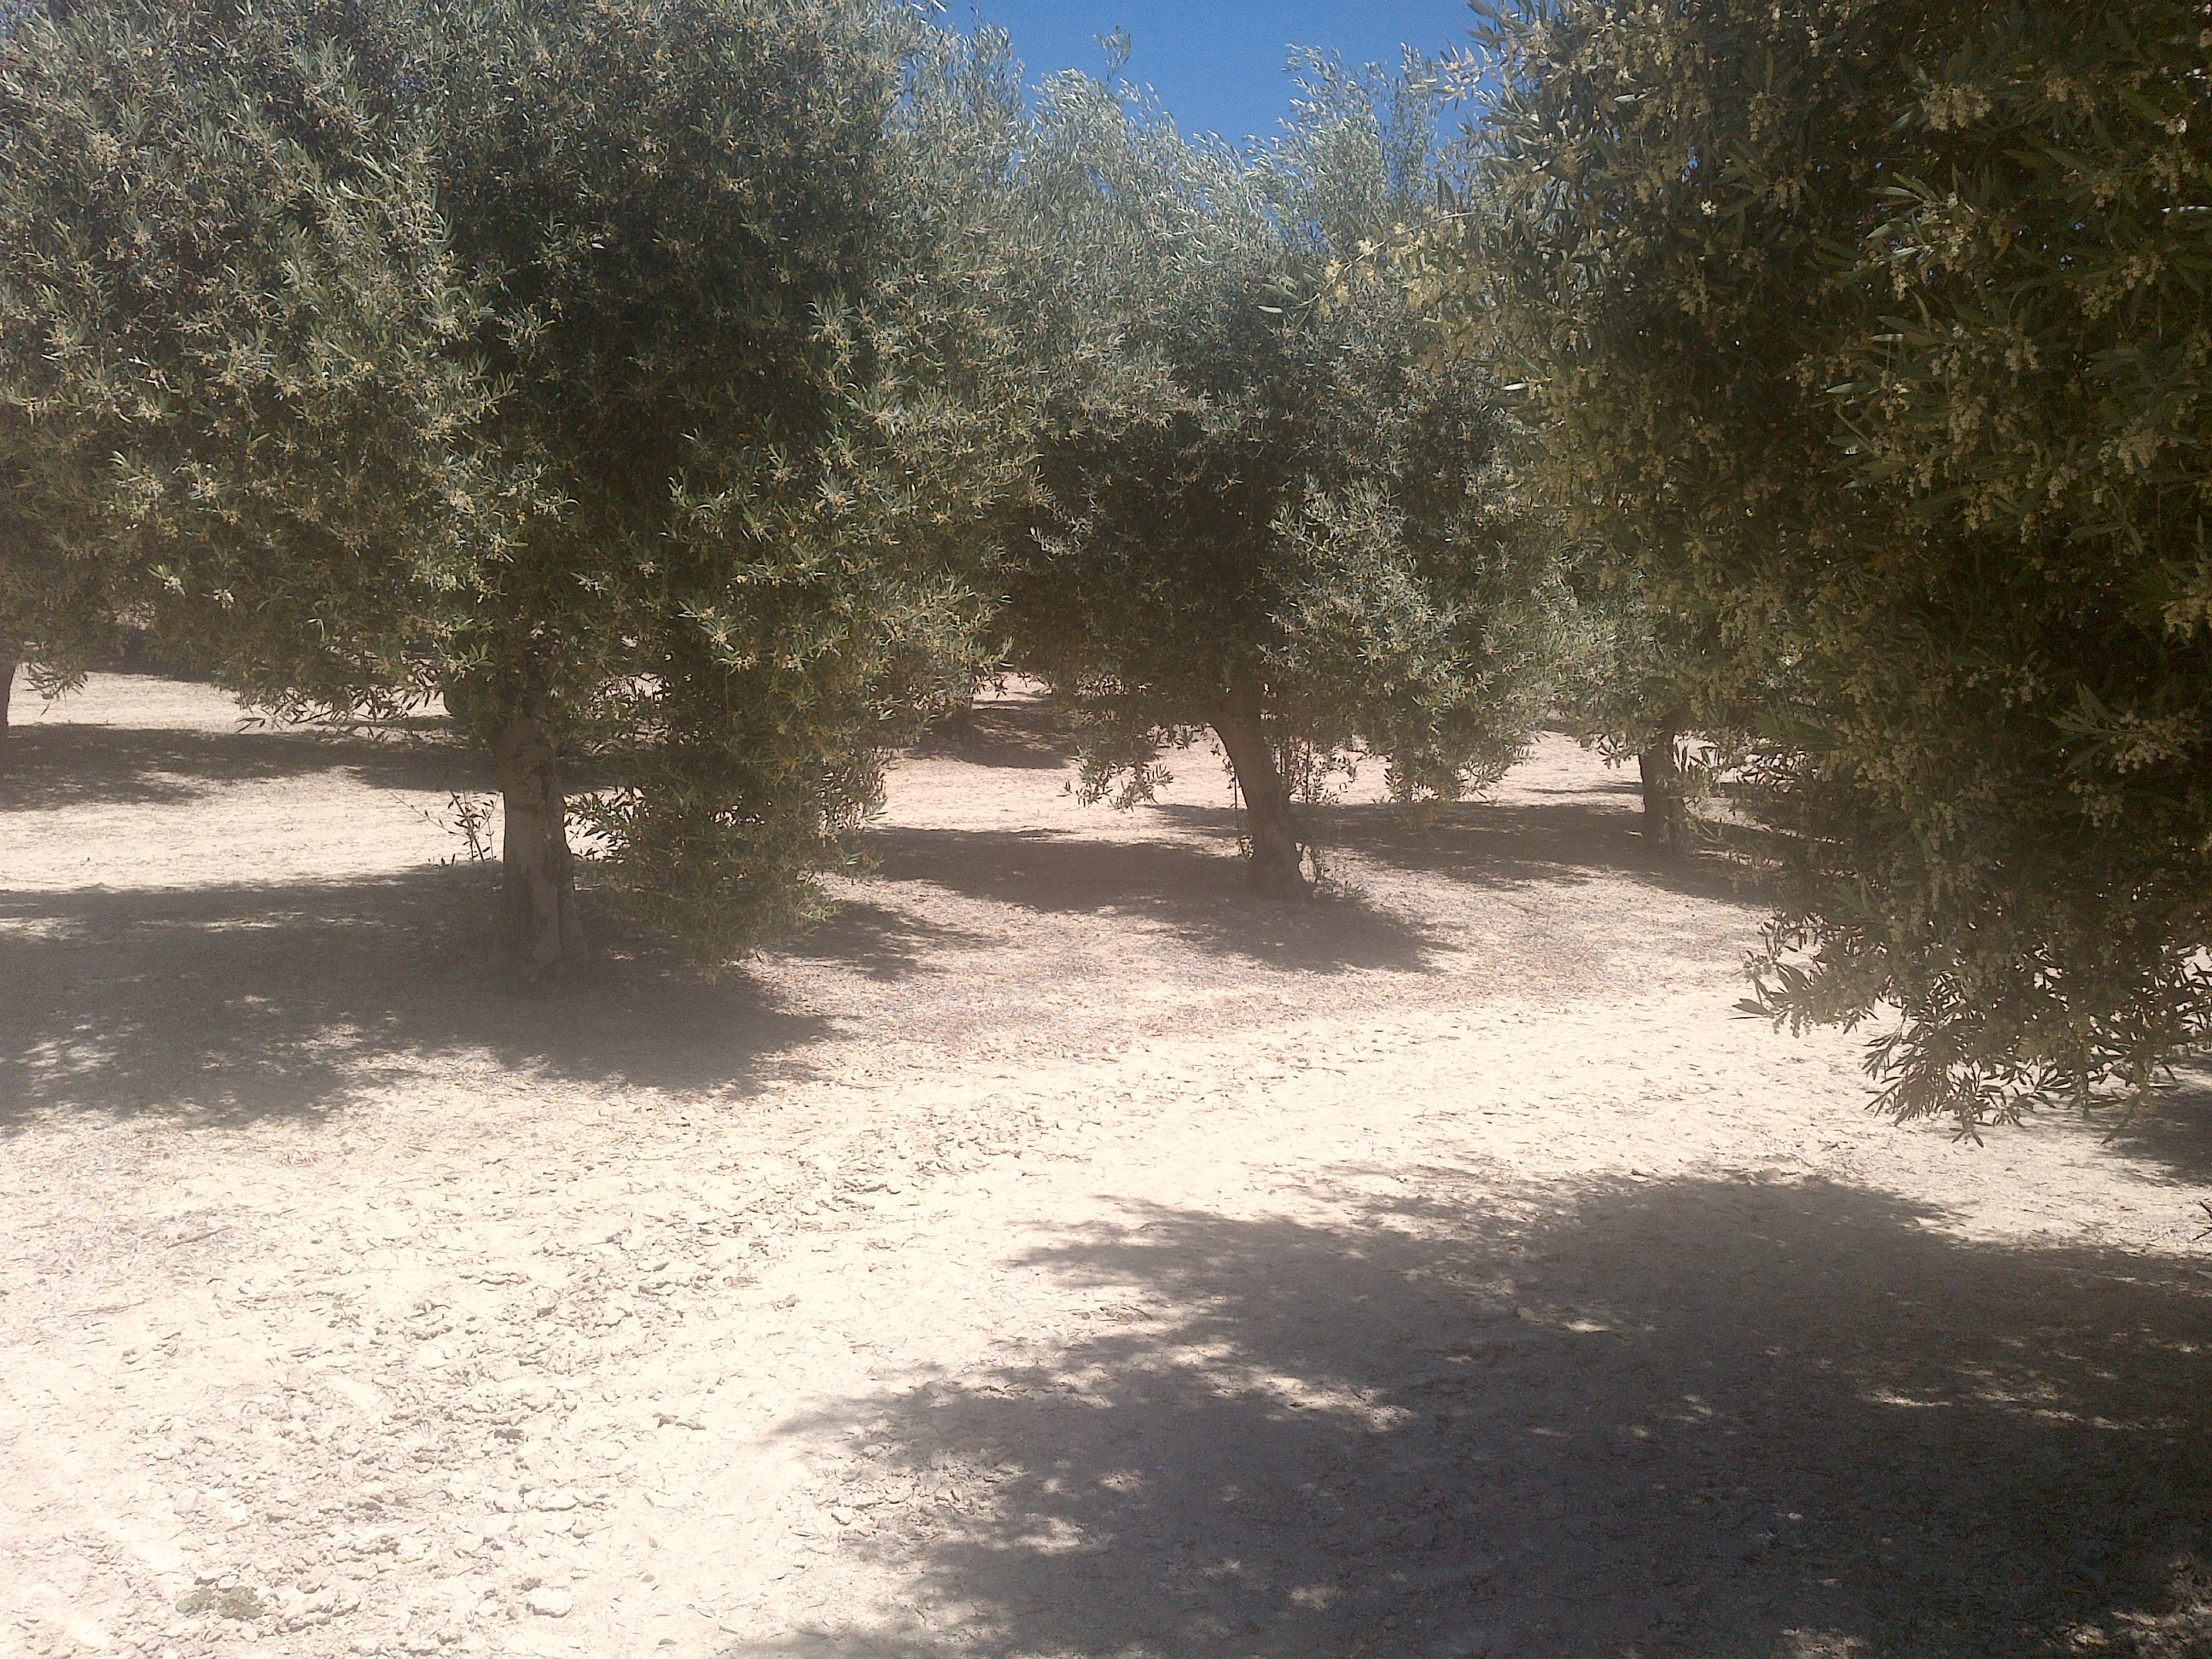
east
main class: Cropland
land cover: Olive groves
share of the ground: 50 - 75 %
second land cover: Other bare soil
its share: > 75 %
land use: Agriculture (excluding fallow land and kitchen gardens)
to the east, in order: Olive groves; Other bare soil
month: May
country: ES
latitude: 37.7694
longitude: -4.6210
